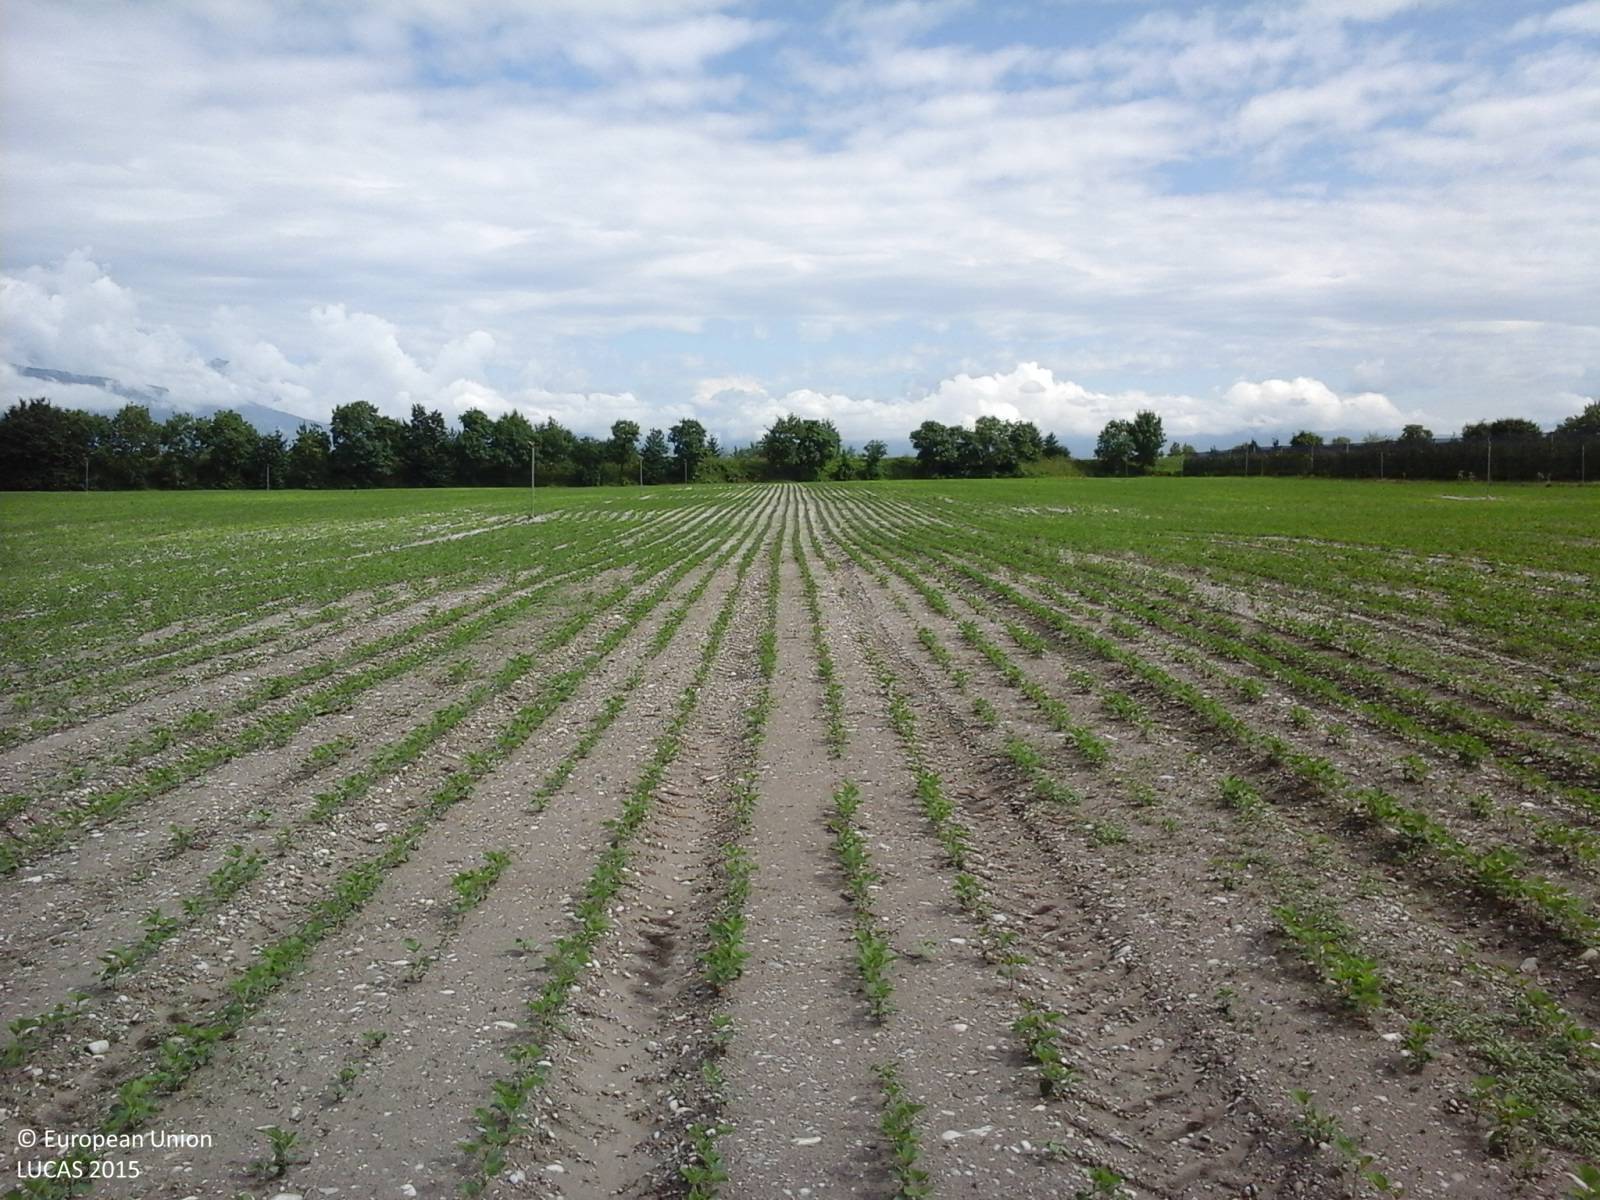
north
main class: Cropland
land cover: Soya
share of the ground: < 10 %
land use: Agriculture (excluding fallow land and kitchen gardens)
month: June
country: IT
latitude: 46.0642
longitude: 12.7244
